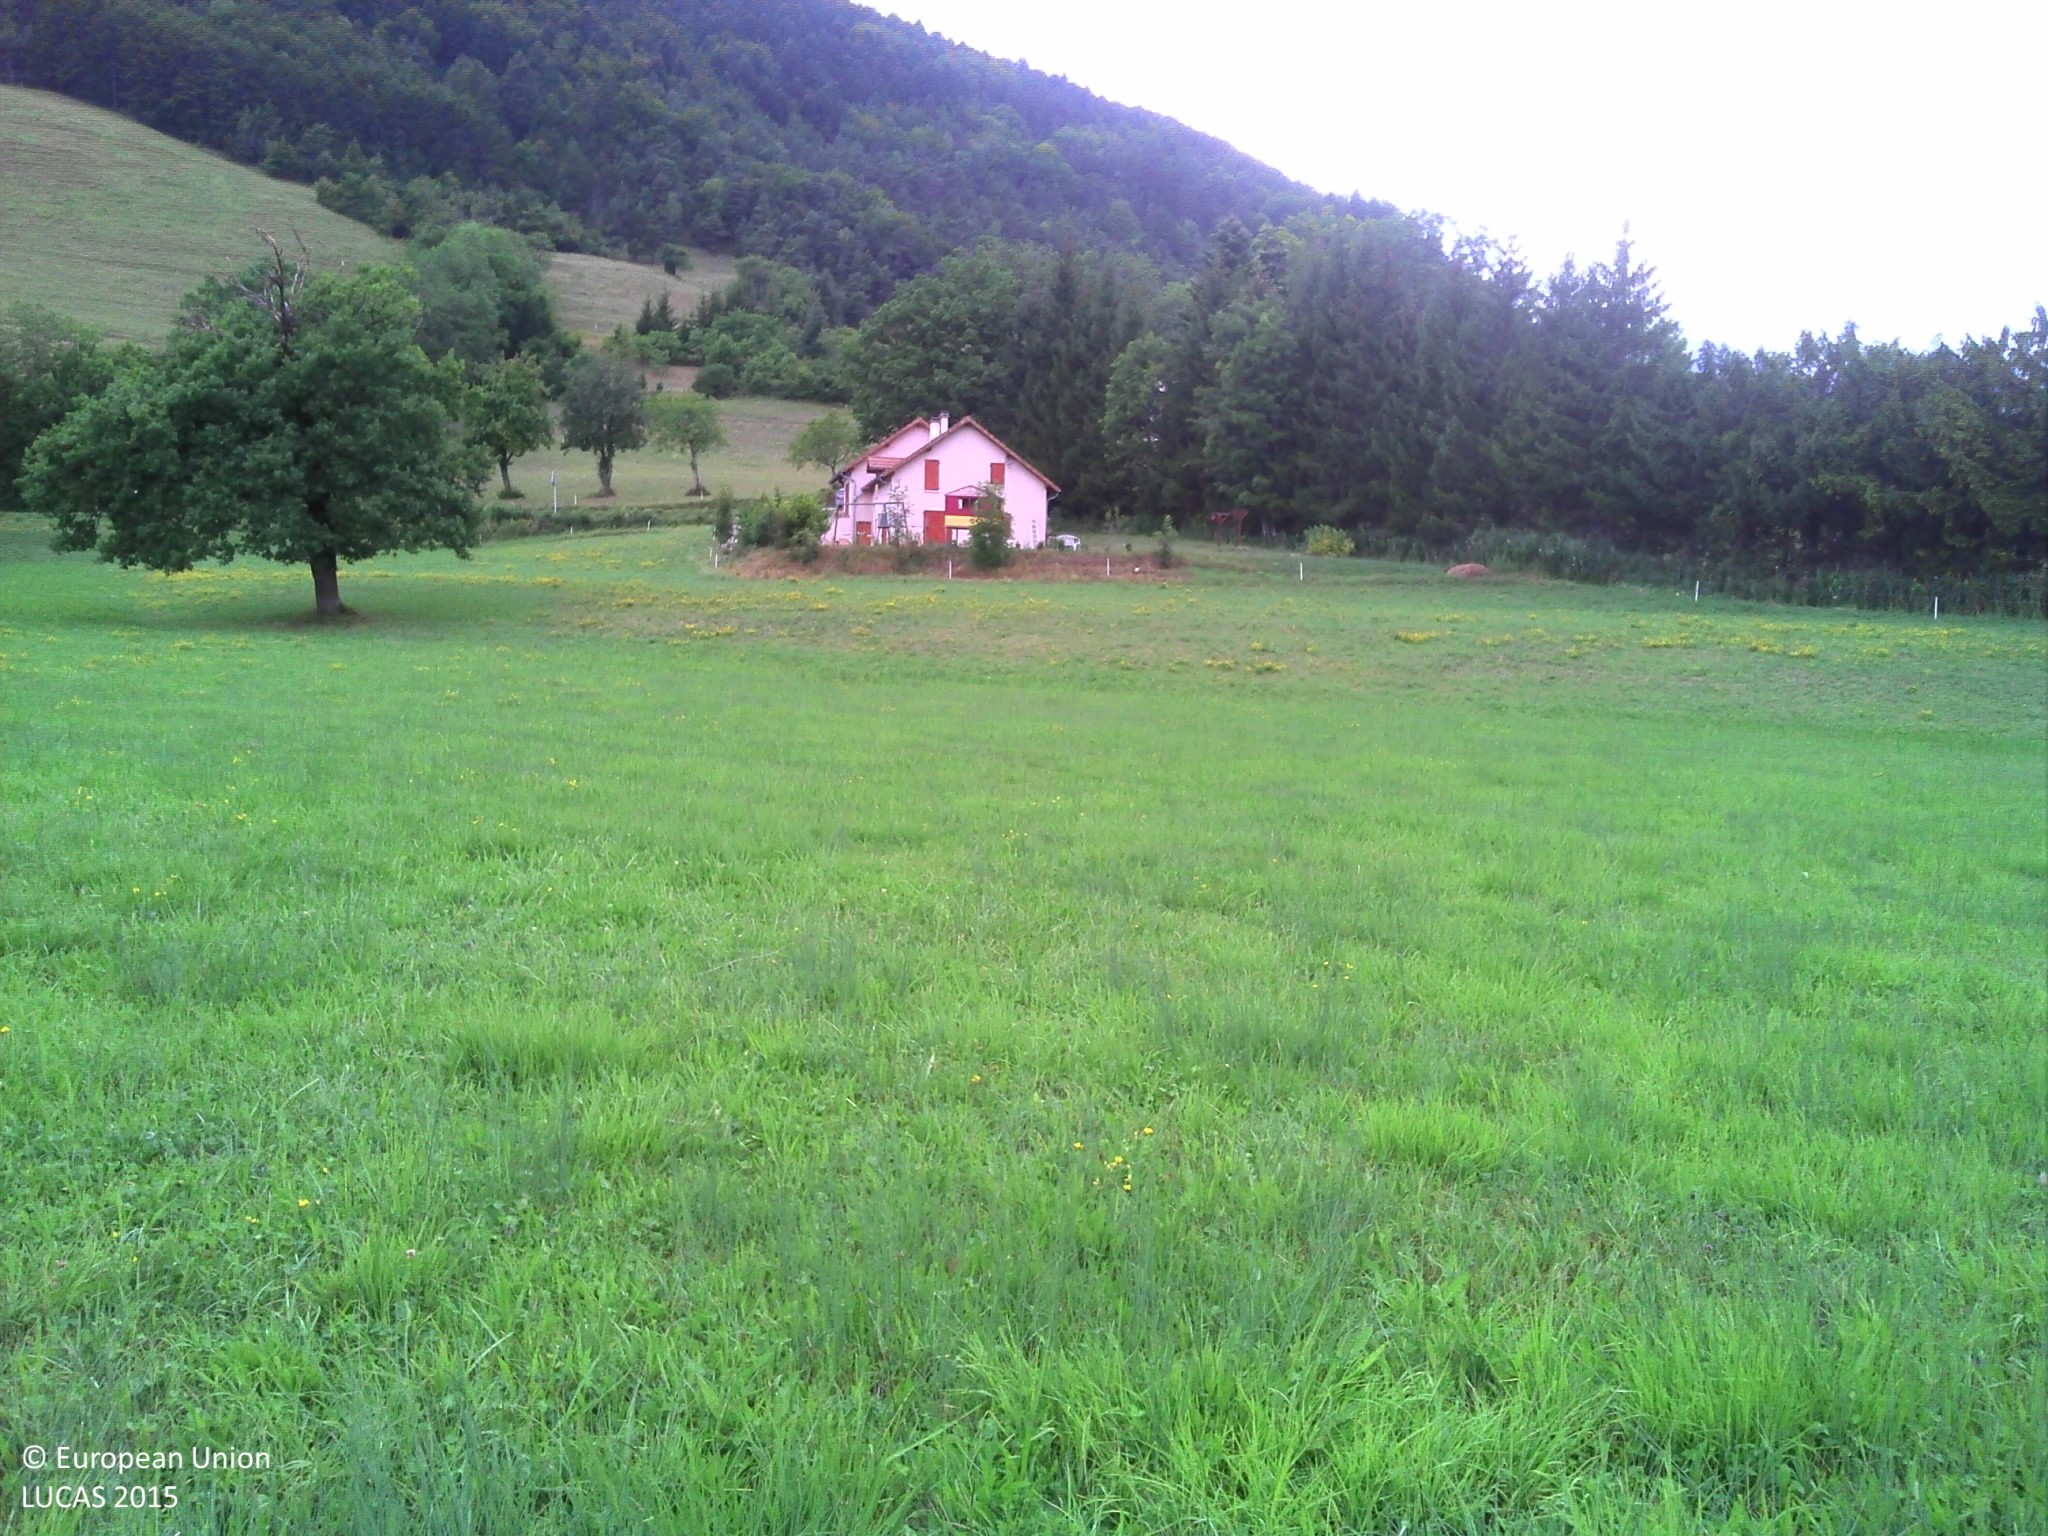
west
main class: Grassland
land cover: Grassland without tree/shrub cover
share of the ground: > 75 %
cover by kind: herbaceous plants 100 %
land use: Agriculture (excluding fallow land and kitchen gardens)
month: July
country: FR
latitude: 44.9438
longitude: 5.6082
